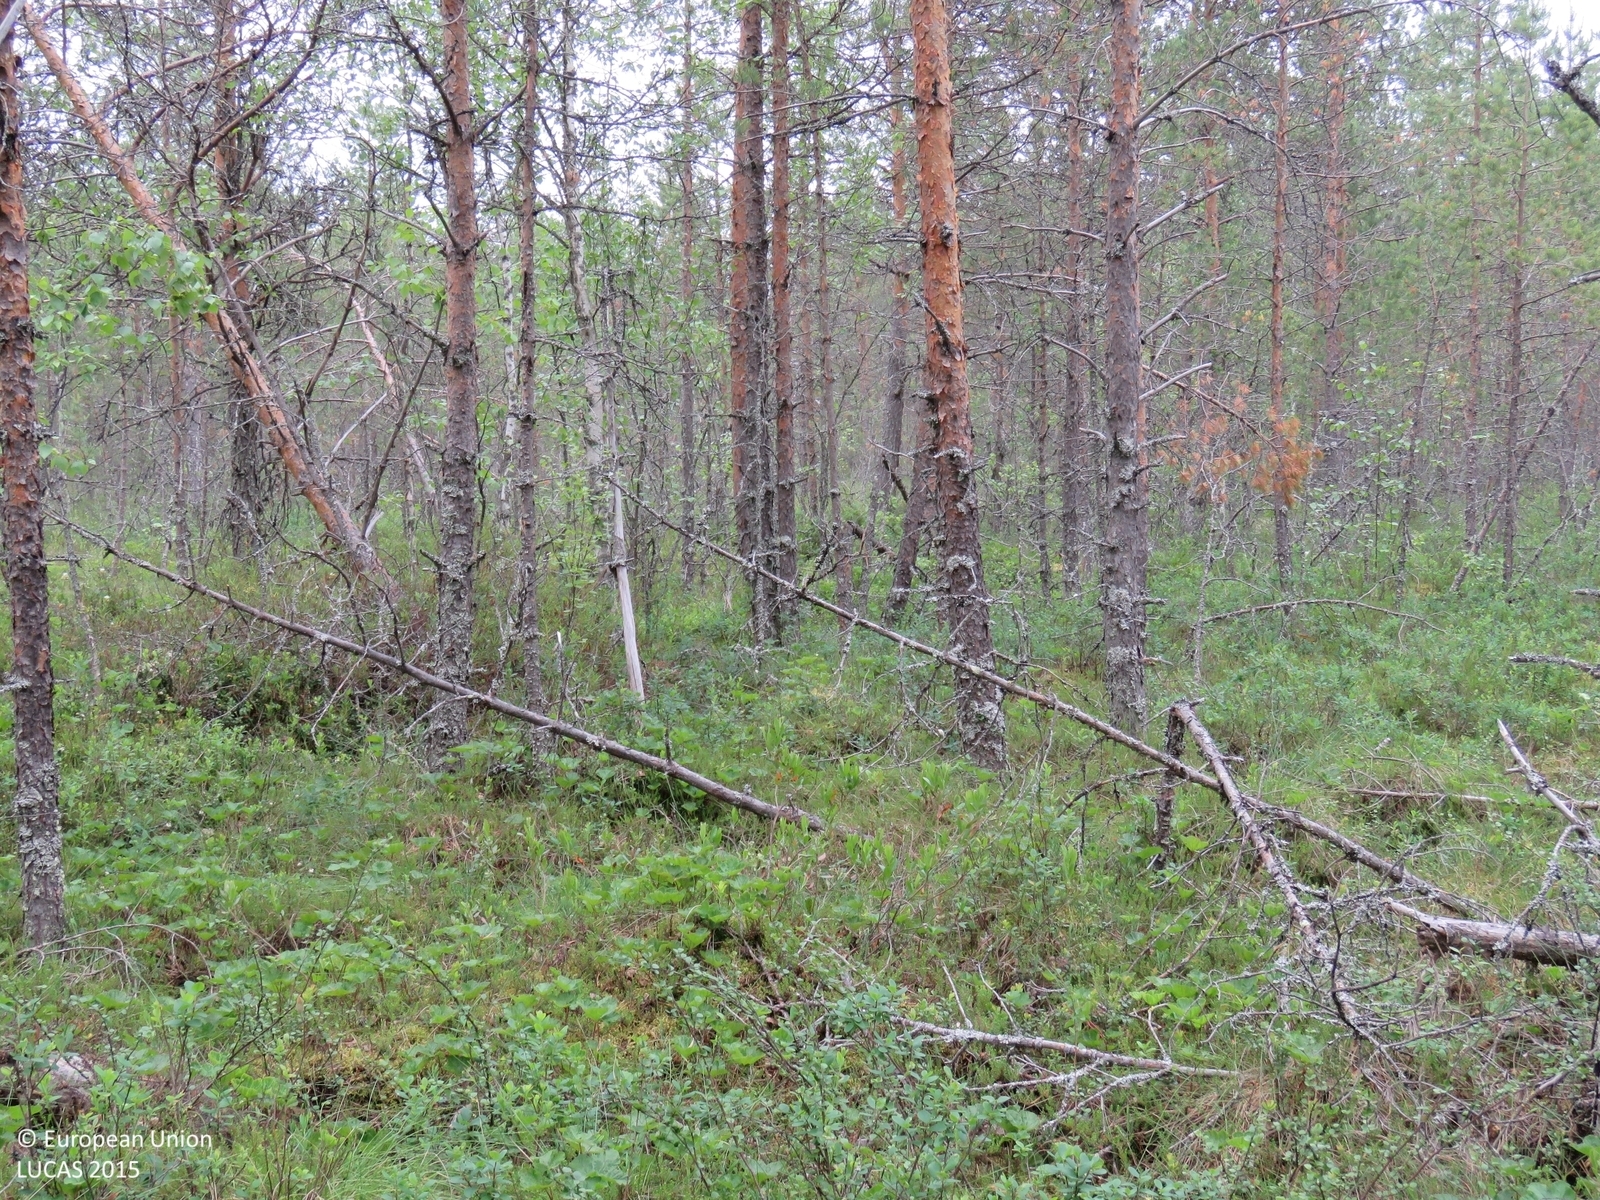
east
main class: Woodland
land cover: Pine dominated coniferous woodland
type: mire and swamp forests
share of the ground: > 75 %
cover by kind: coniferous forest trees 70 %, broadleaved forest trees 10 %, shrubs 10 %, herbaceous plants 10 %
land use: Forestry
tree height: > 5 m
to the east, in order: Pine dominated coniferous woodland; Ditches and canals; Pine dominated coniferous woodland; Ditches and canals; Pine dominated coniferous woodland; Ditches and canals; Pine dominated mixed woodland; Pine dominated coniferous woodland
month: July
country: FI
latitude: 64.1772
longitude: 26.6452
